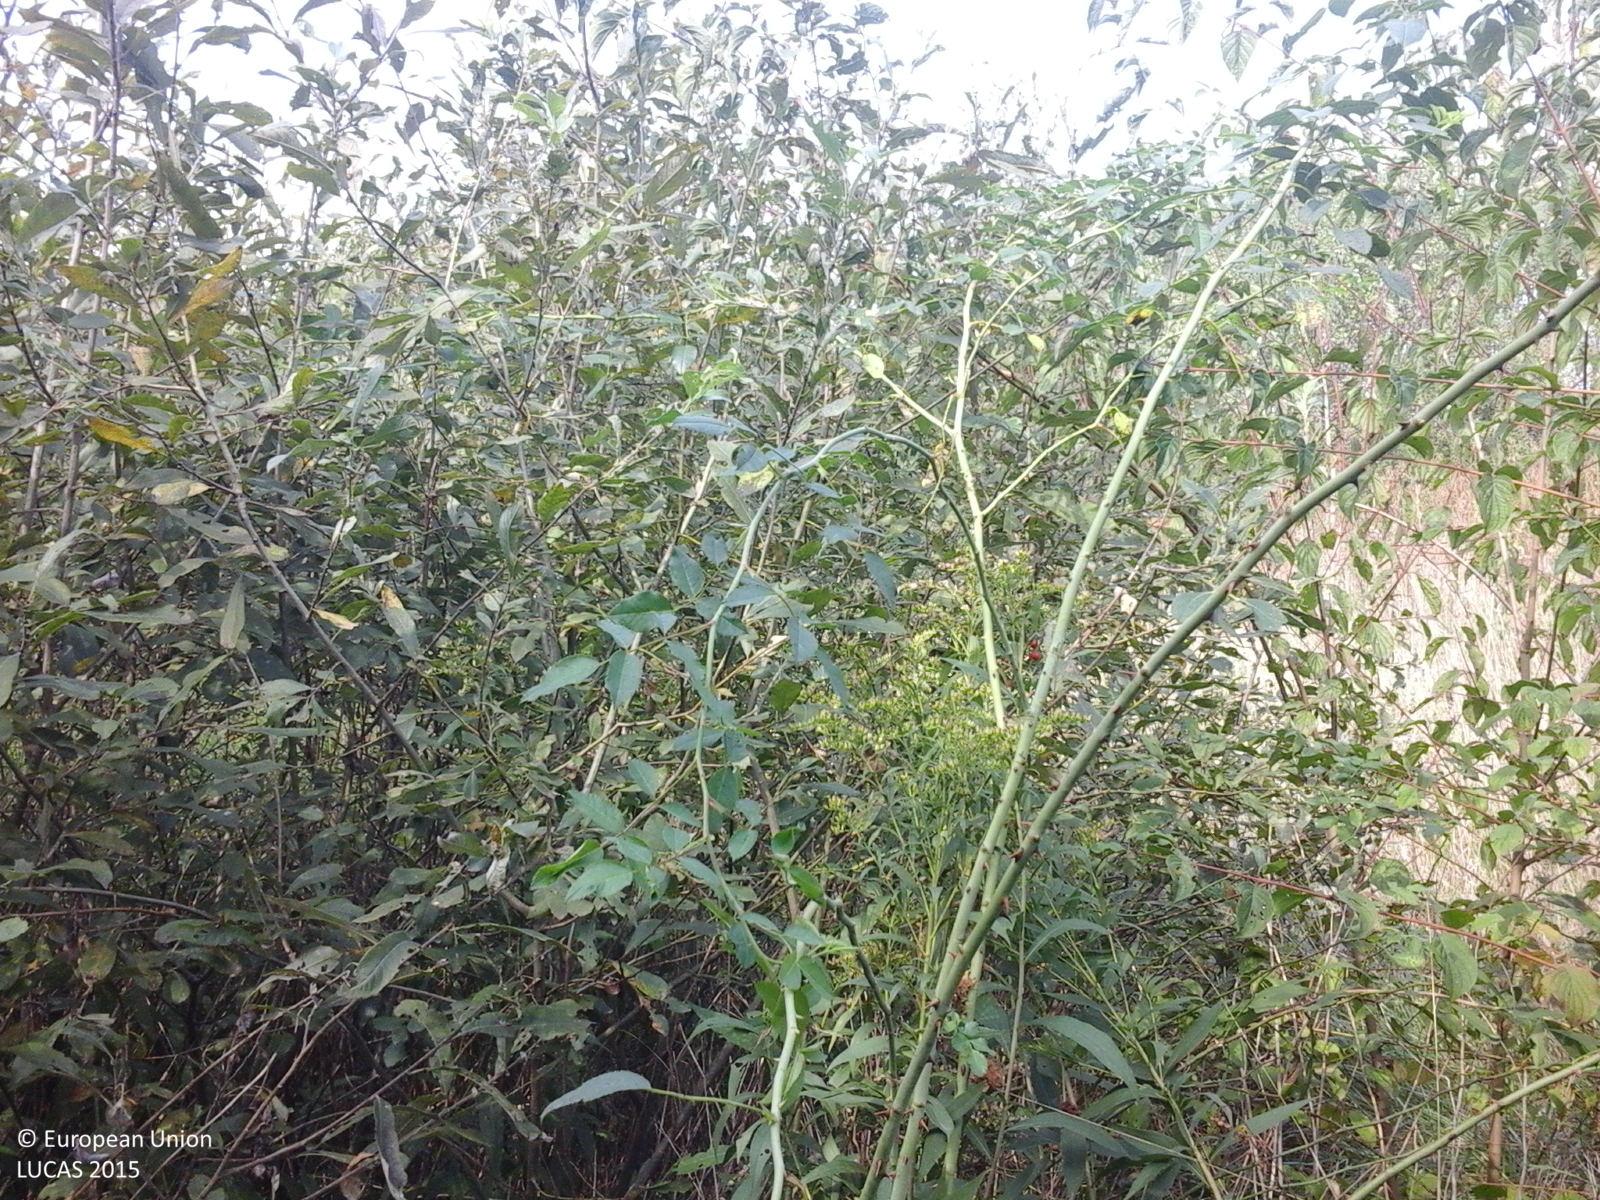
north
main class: Woodland
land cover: Broadleaved woodland
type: non-riverine alder, birch or aspen forest
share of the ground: > 75 %
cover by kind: broadleaved forest trees 100 %
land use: Semi-natural and natural areas not in use
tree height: < 5 m
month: September
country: RO
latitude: 45.5086
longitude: 22.1619
